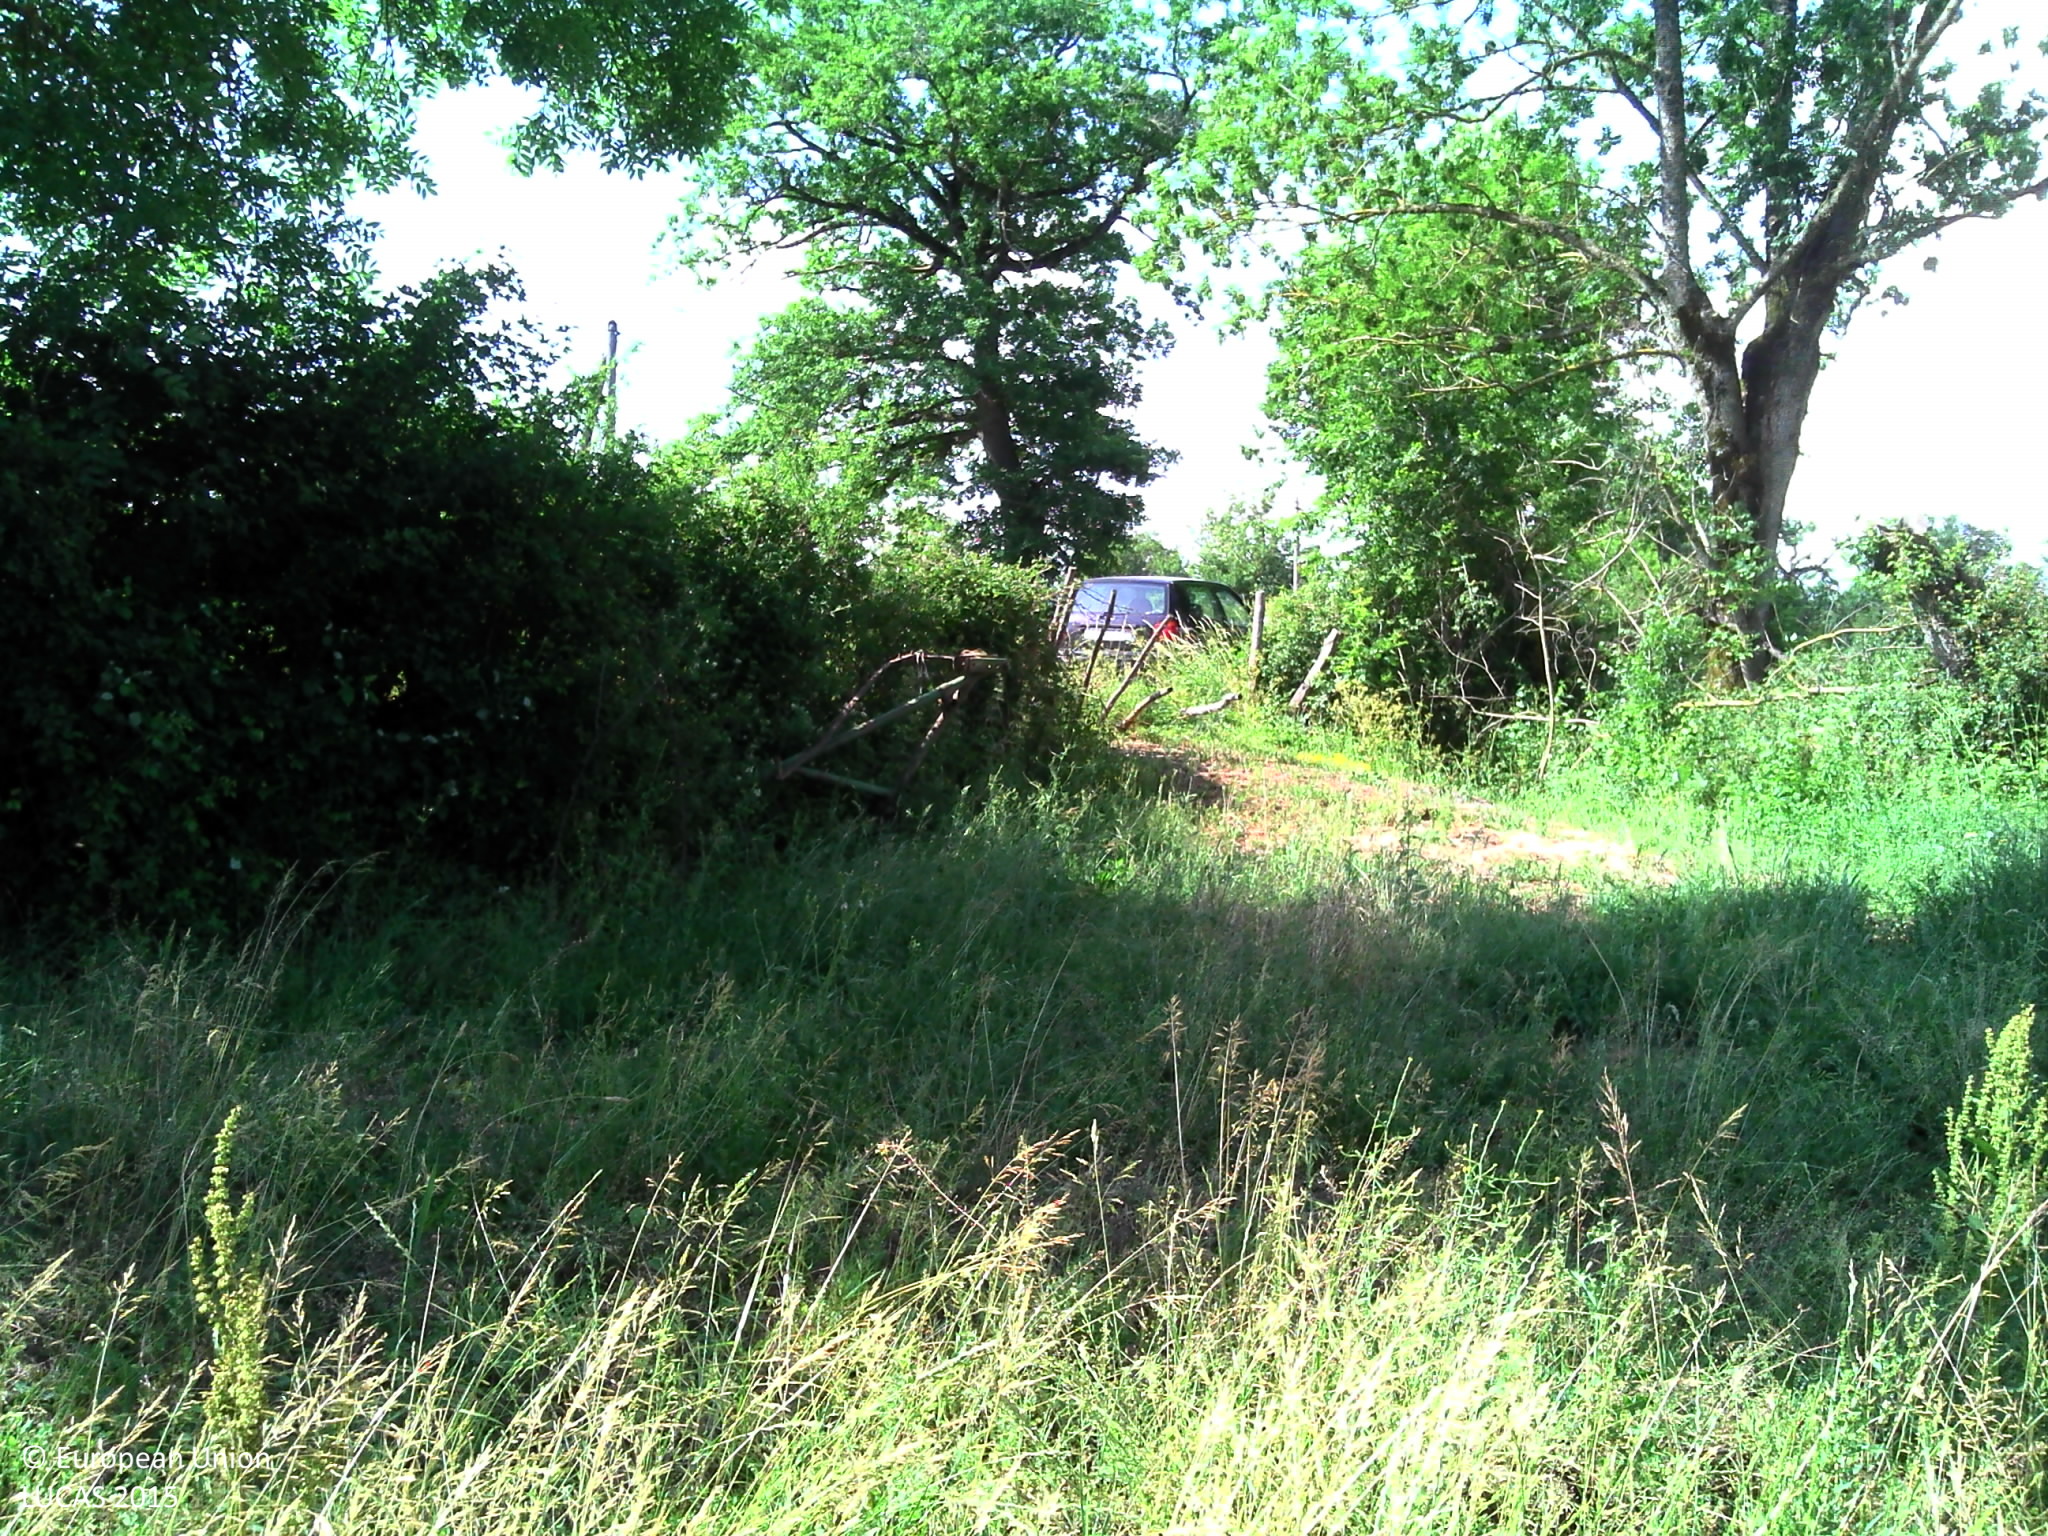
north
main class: Grassland
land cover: Grassland without tree/shrub cover
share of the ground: > 75 %
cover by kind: herbaceous plants 95 %, shrubs 5 %
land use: Agriculture (excluding fallow land and kitchen gardens)
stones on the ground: 10 - 25 %
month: June
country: FR
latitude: 44.3291
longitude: 2.9695
